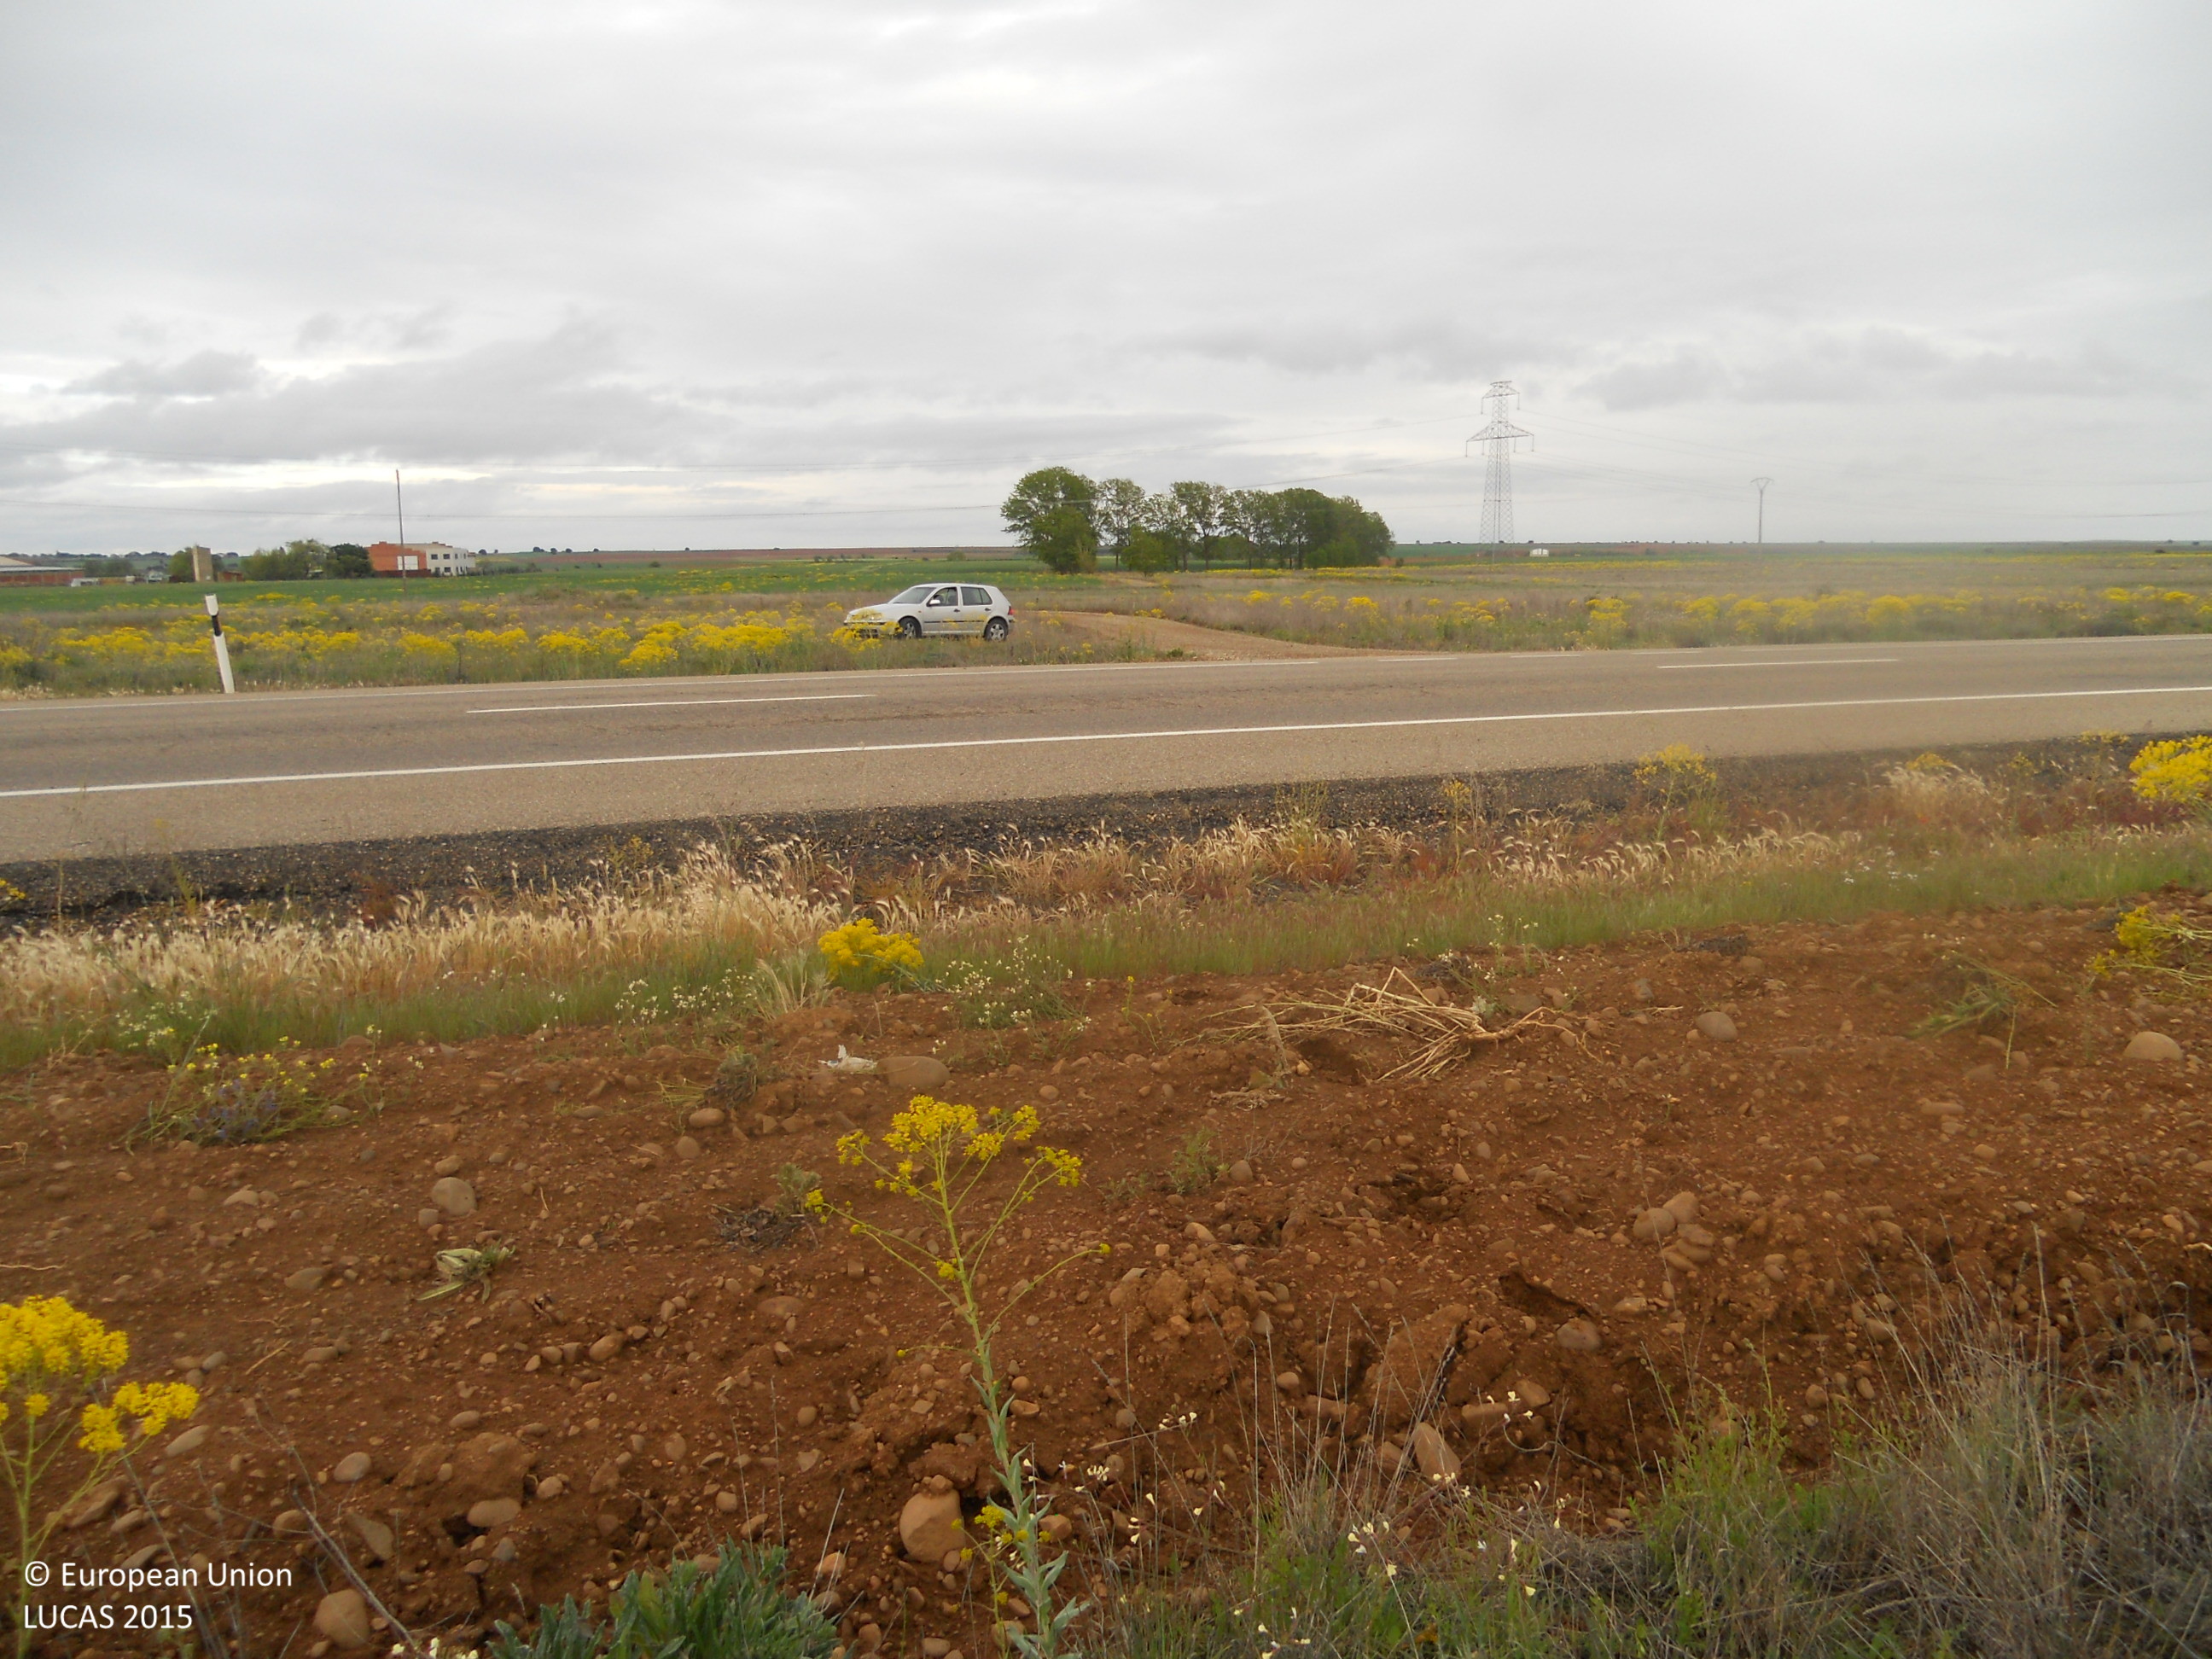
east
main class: Grassland
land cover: Spontaneously vegetated surfaces
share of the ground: > 75 %
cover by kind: herbaceous plants 80 %, unconsolidated bare surface 20 %
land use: Fallow land
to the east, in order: Spontaneously vegetated surfaces; Other bare soil; Grass margins; Paved roads, cycling and walking lanes; Spontaneously vegetated surfaces; Tracks; Spontaneously vegetated surfaces; Tracks; Common wheat; Grass margins; Tracks; Single bushes/trees
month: May
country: ES
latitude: 42.2756
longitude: -5.2802
